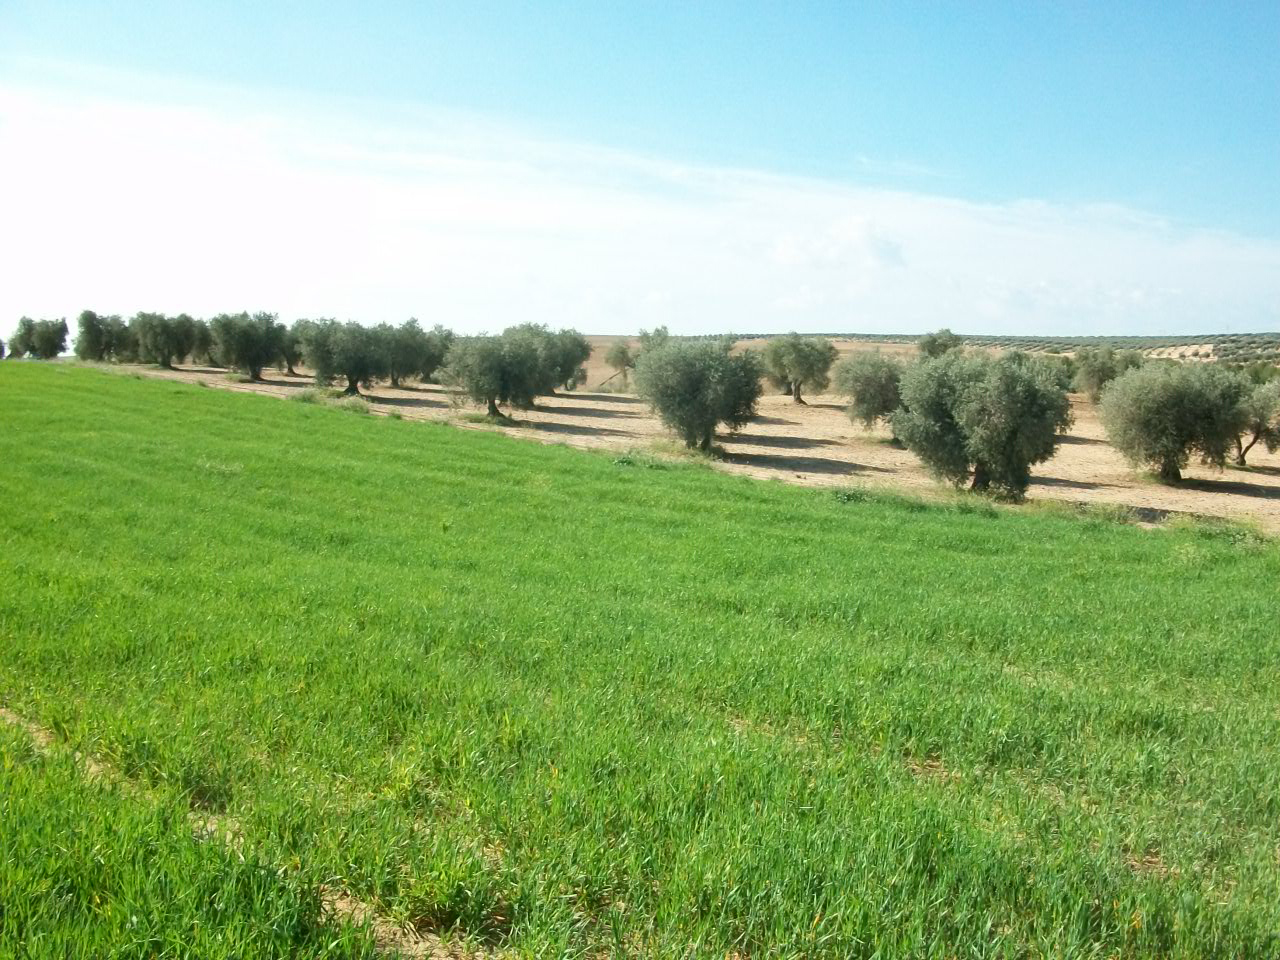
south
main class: Cropland
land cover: Barley
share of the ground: > 75 %
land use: Agriculture (excluding fallow land and kitchen gardens)
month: April
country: ES
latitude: 39.8777
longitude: -3.7698
